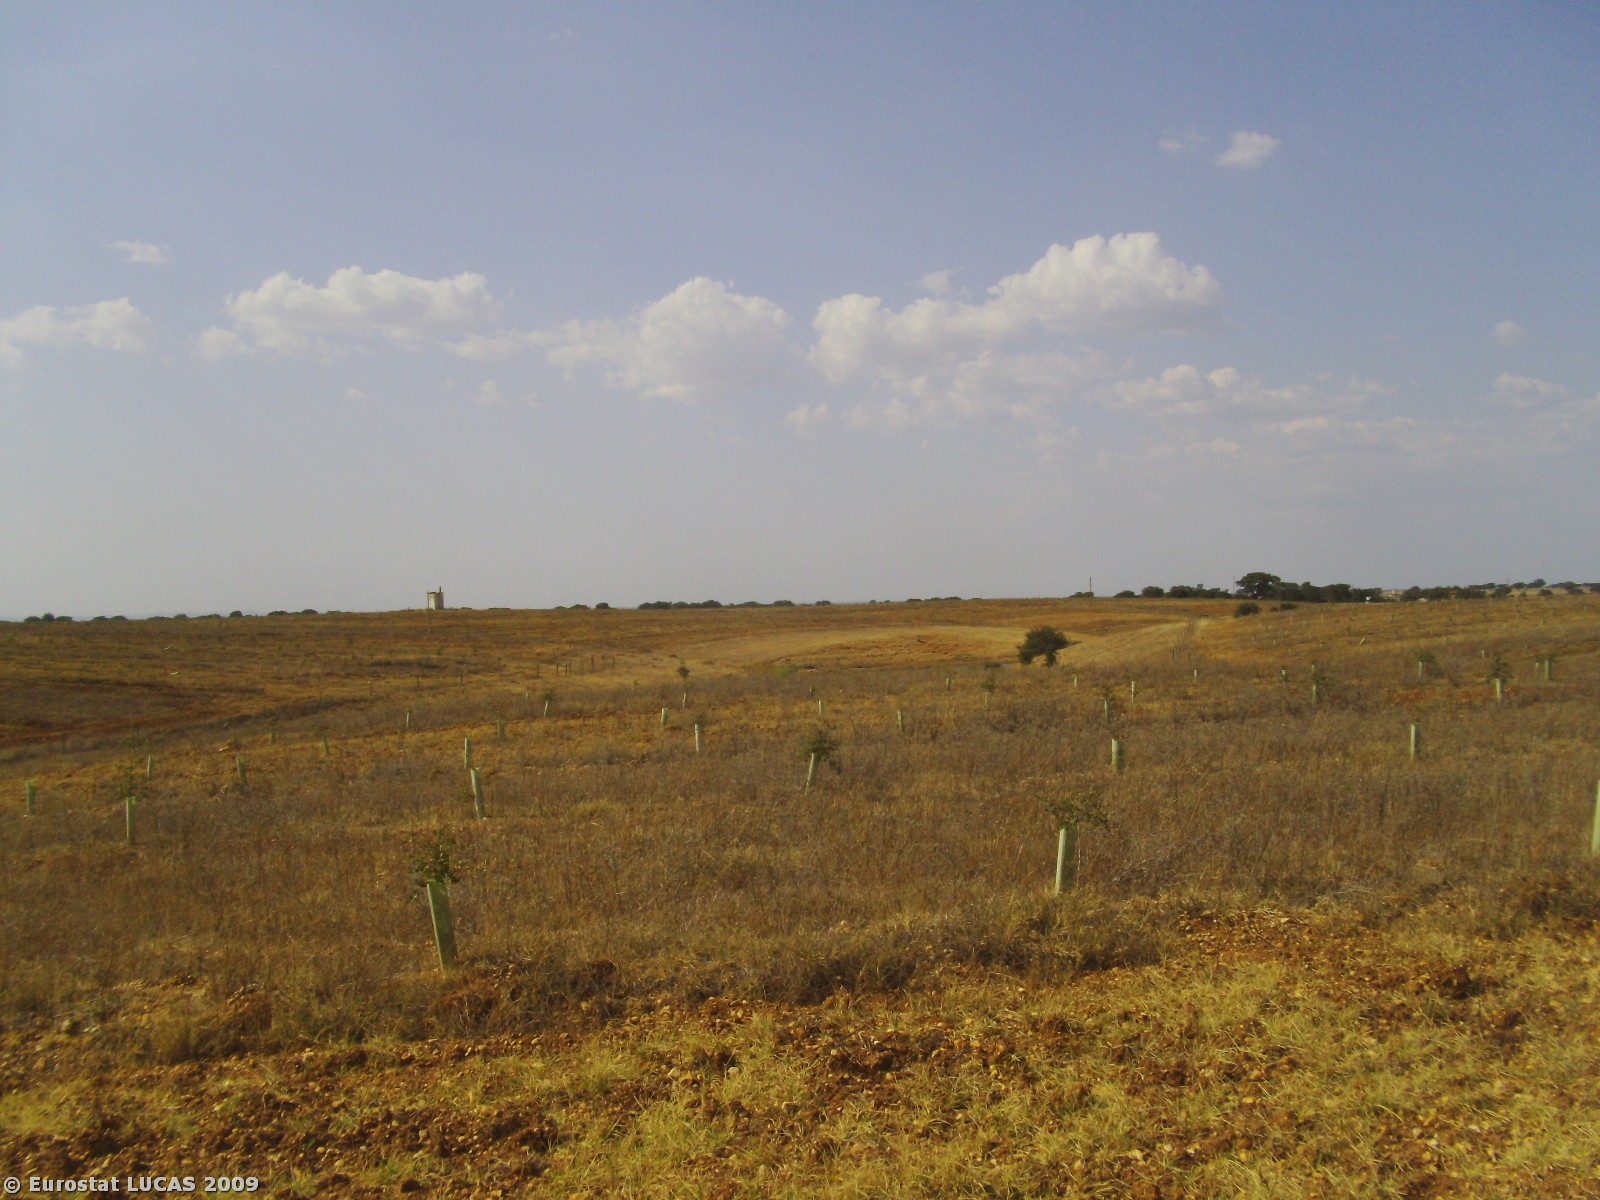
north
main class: Woodland
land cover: Broadleaved woodland
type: broadleaved evergreen forest
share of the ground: 10 - 25 %
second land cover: Spontaneously vegetated surfaces
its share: 50 - 75 %
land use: Forestry
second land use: Fallow land
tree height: < 5 m
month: August
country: PT
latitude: 37.9024
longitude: -8.2891
